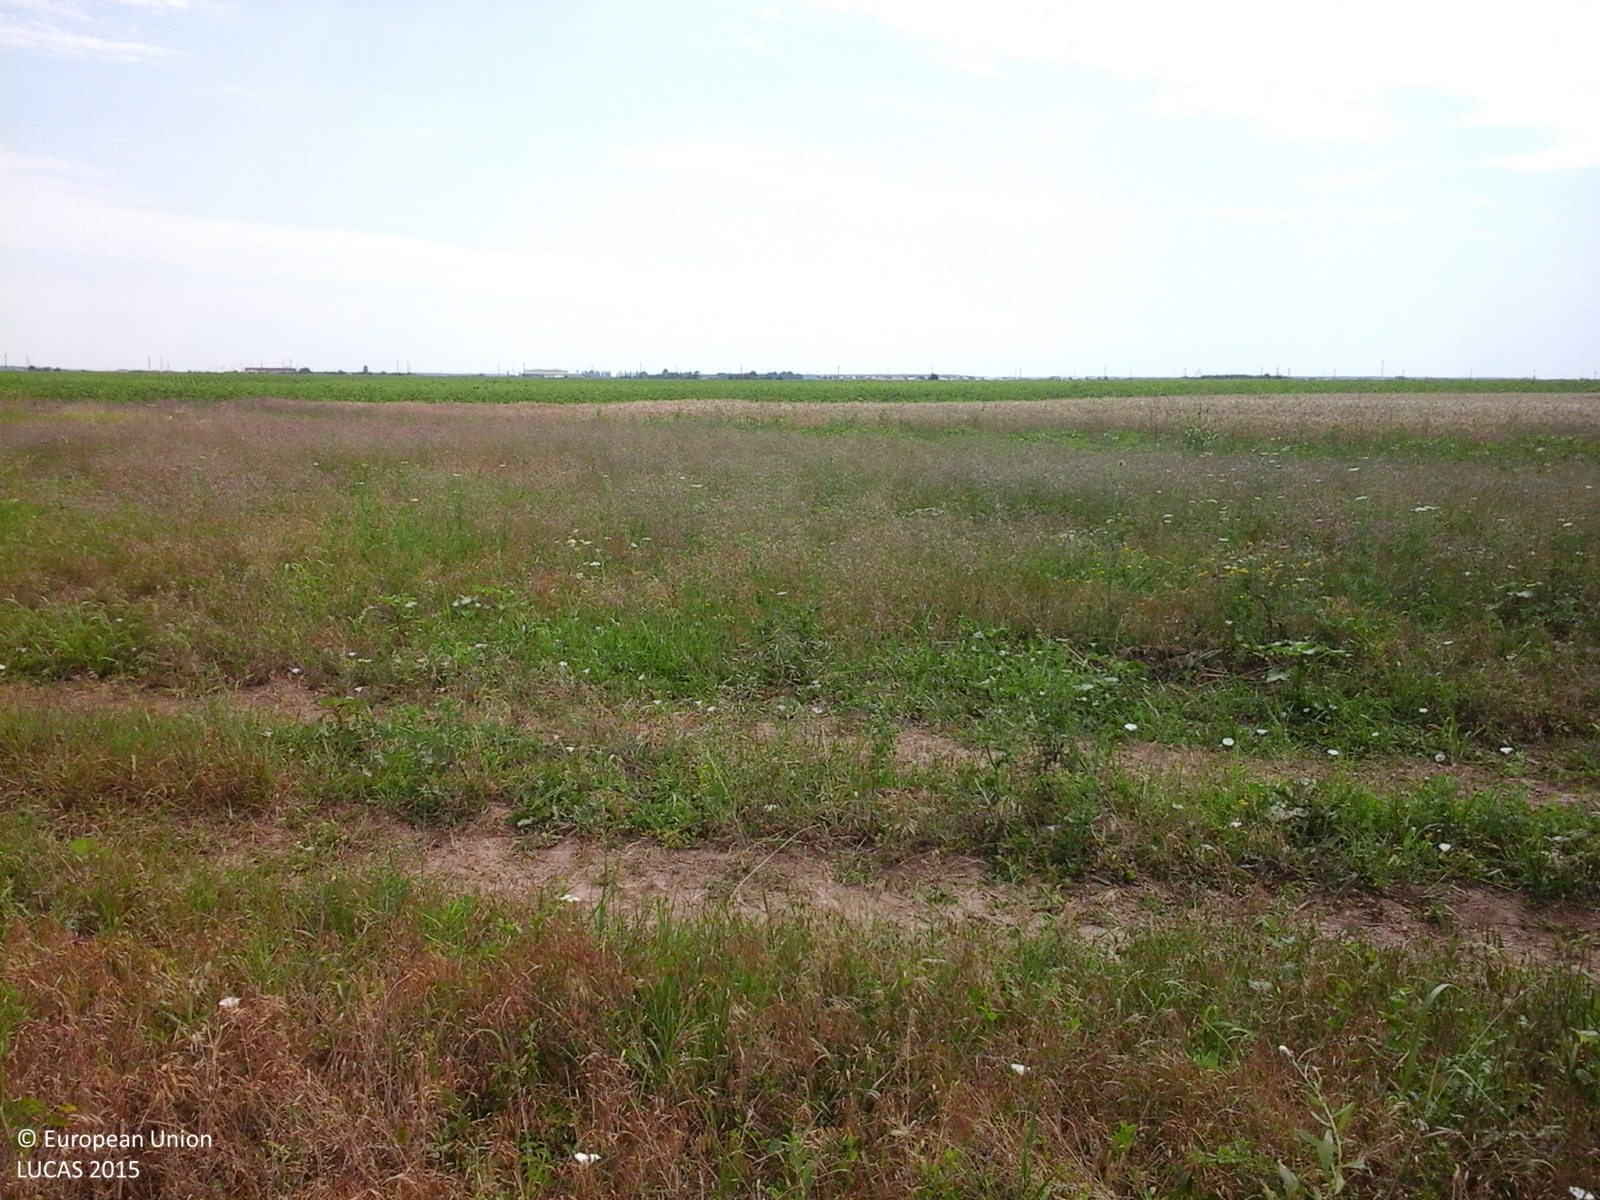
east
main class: Grassland
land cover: Grassland without tree/shrub cover
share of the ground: > 75 %
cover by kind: herbaceous plants 100 %
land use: Agriculture (excluding fallow land and kitchen gardens)
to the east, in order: Grassland without tree/shrub cover; Tracks; Grassland without tree/shrub cover; Tracks; Grassland without tree/shrub cover; Spontaneously vegetated surfaces; Common wheat; Grass margins; Tracks; Grass margins; Sunflower
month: June
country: RO
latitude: 44.6080
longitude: 26.0964
